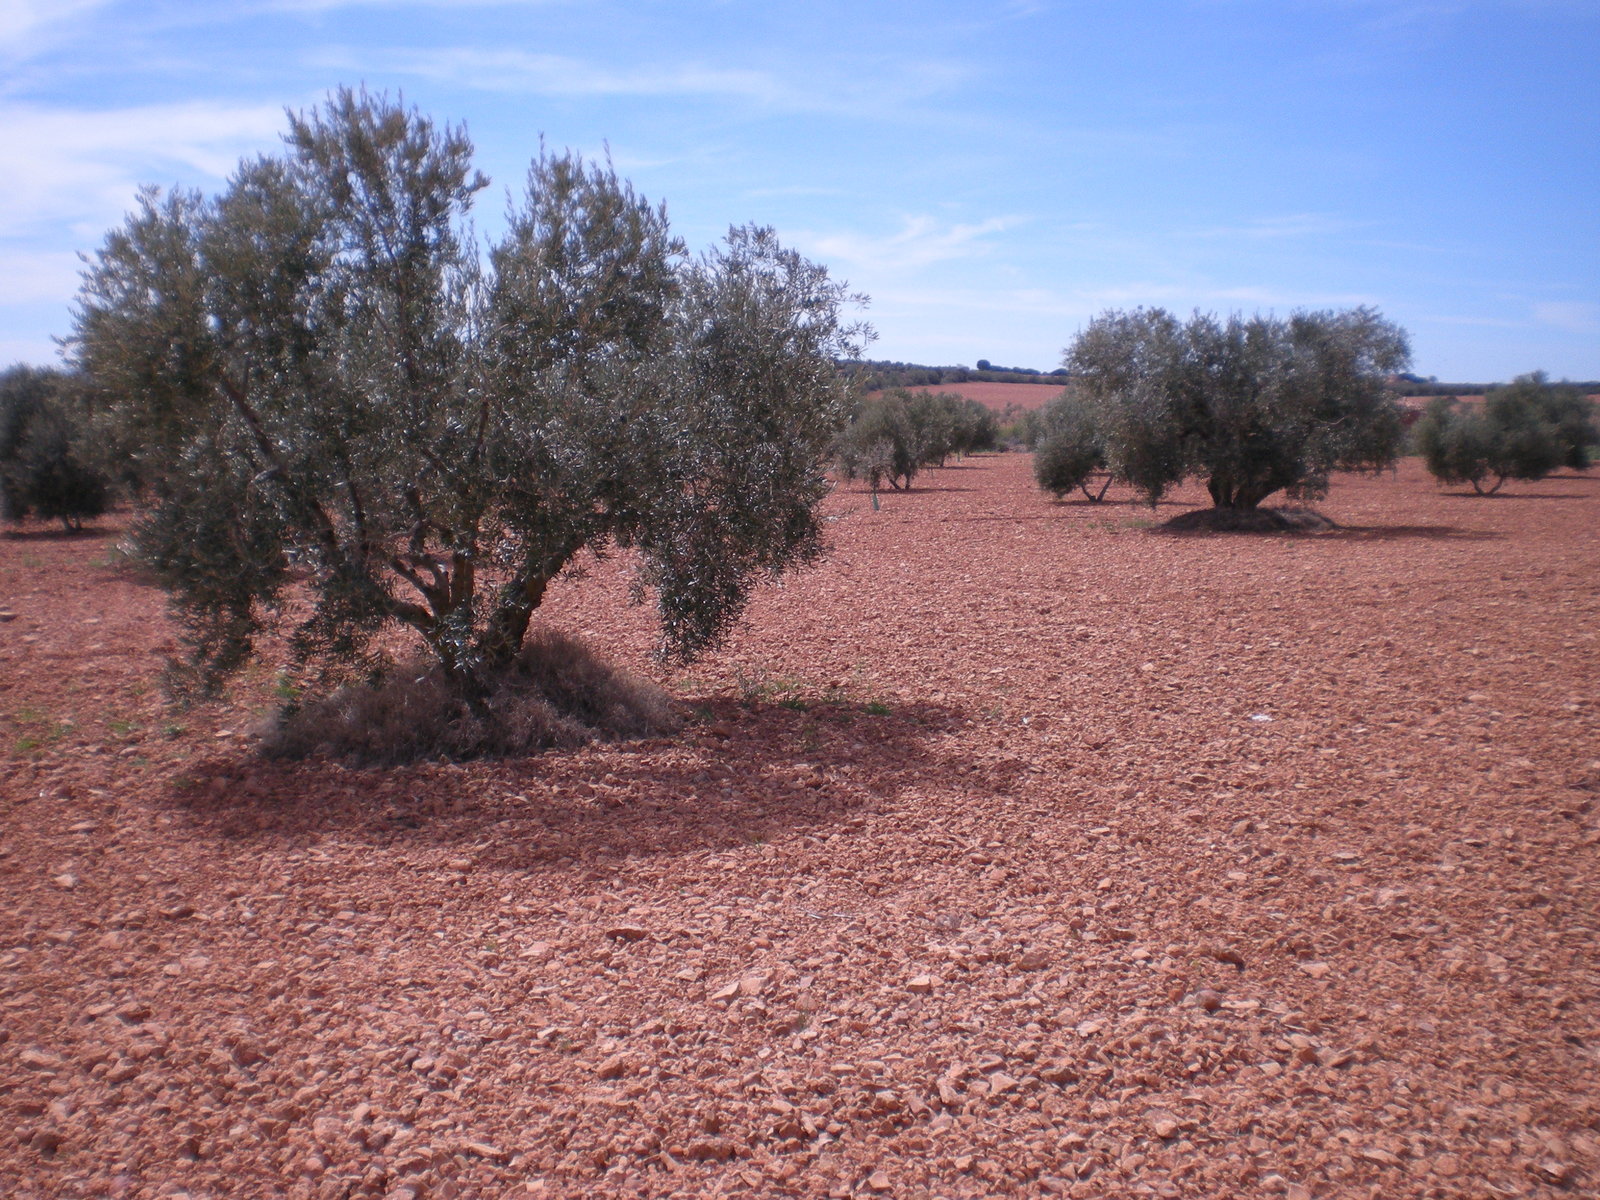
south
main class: Cropland
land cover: Olive groves
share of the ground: 10 - 25 %
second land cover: Other bare soil
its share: > 75 %
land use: Agriculture (excluding fallow land and kitchen gardens)
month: March
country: ES
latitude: 39.0181
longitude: -3.2374
